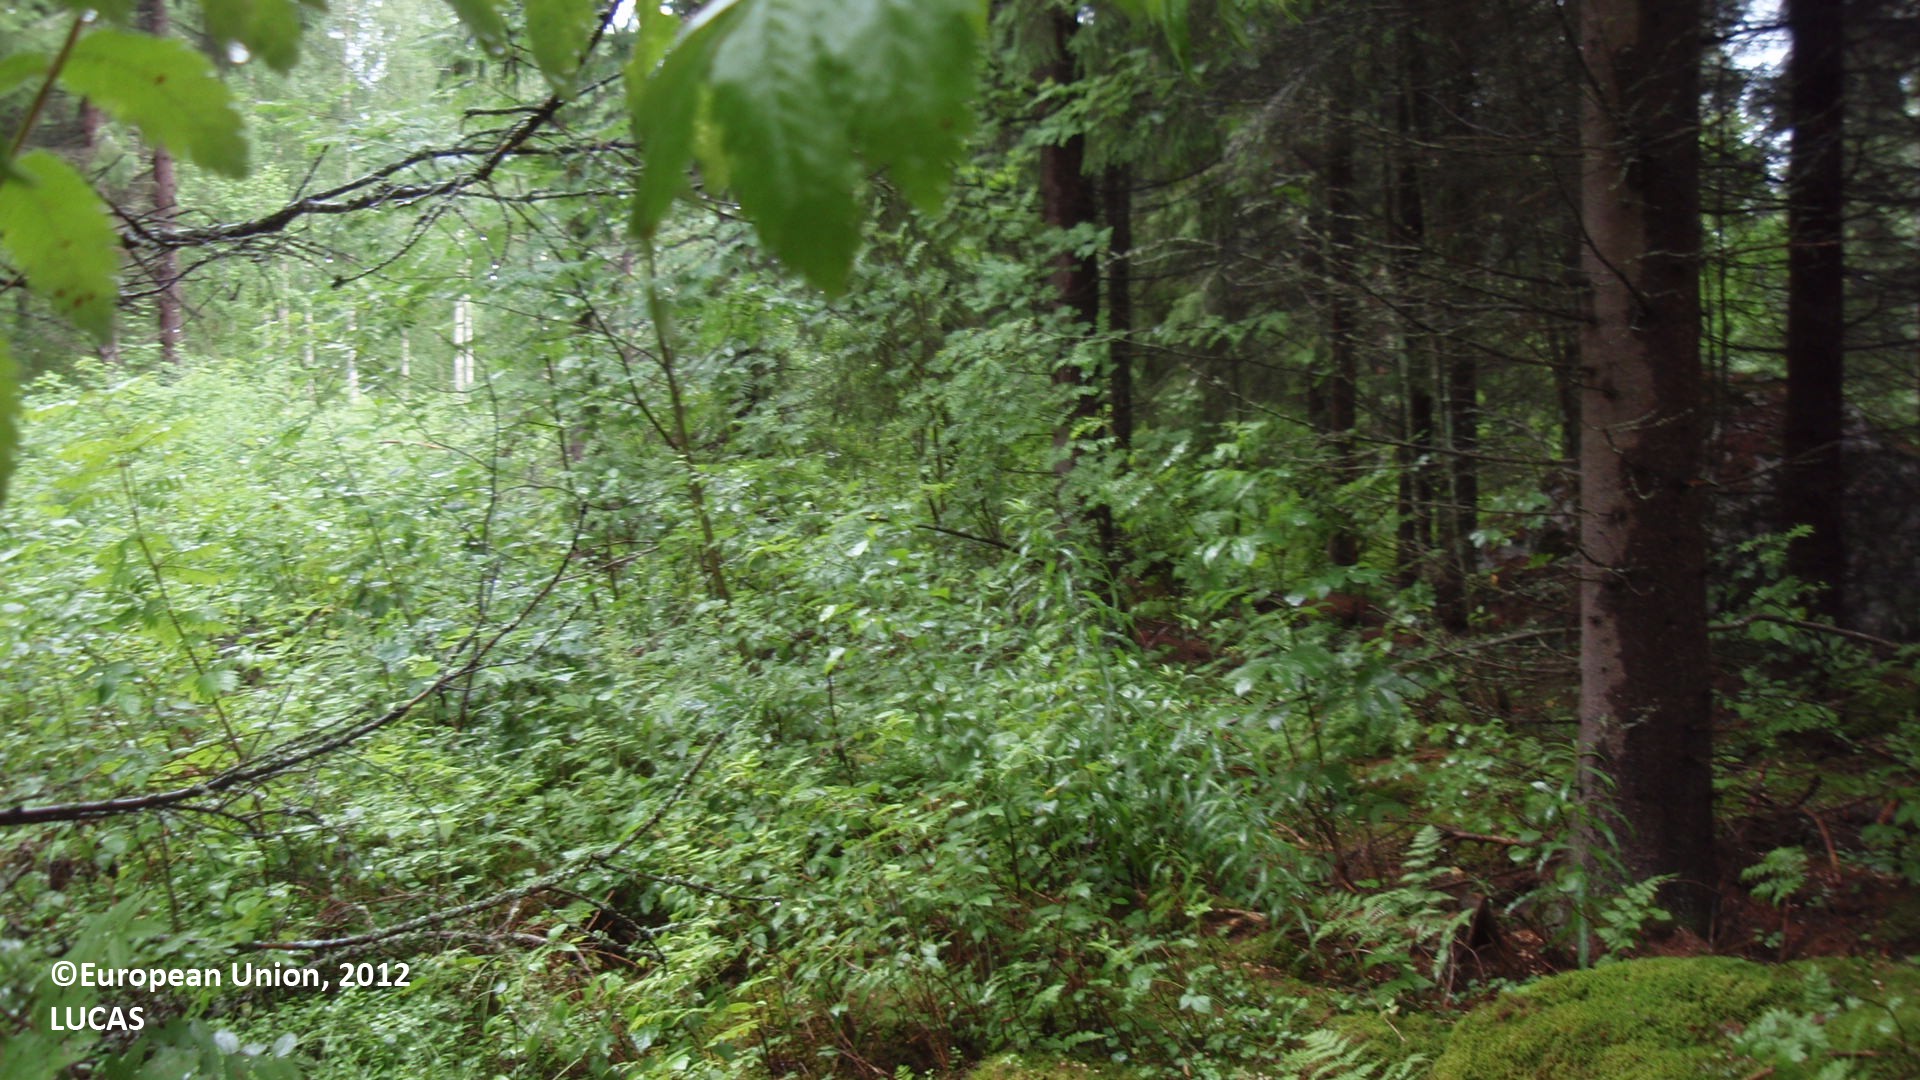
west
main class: Woodland
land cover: Spruce dominated coniferous woodland
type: boreal forest
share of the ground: > 75 %
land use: Forestry
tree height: > 5 m
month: July
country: FI
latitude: 61.6373
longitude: 27.2844
